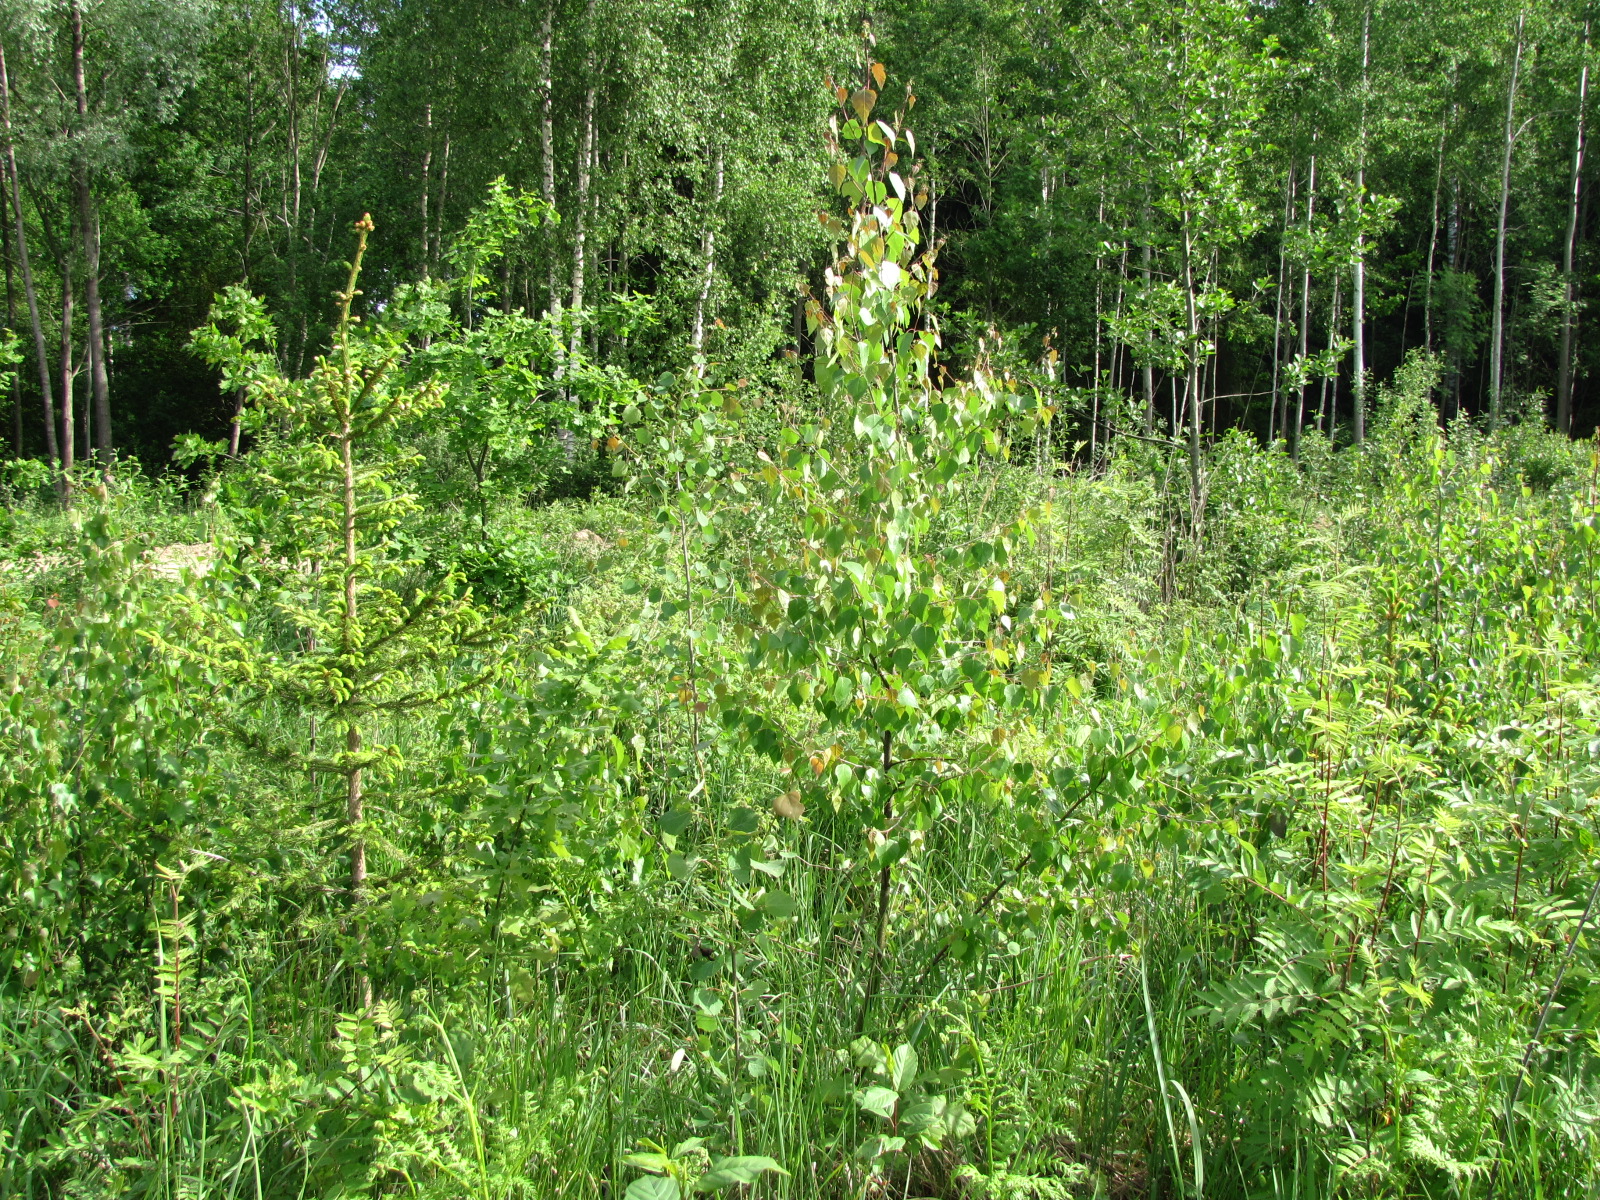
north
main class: Woodland
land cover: Spruce dominated mixed woodland
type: hemiboreal forest and nemoral coniferous forest and mixed broadleaved-coniferous forest
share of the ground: 50 - 75 %
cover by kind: broadleaved forest trees 40 %, coniferous forest trees 30 %, herbaceous plants 30 %
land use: Forestry
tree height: < 5 m
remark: Nursery
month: June
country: LV
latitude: 56.7005
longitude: 23.9487
